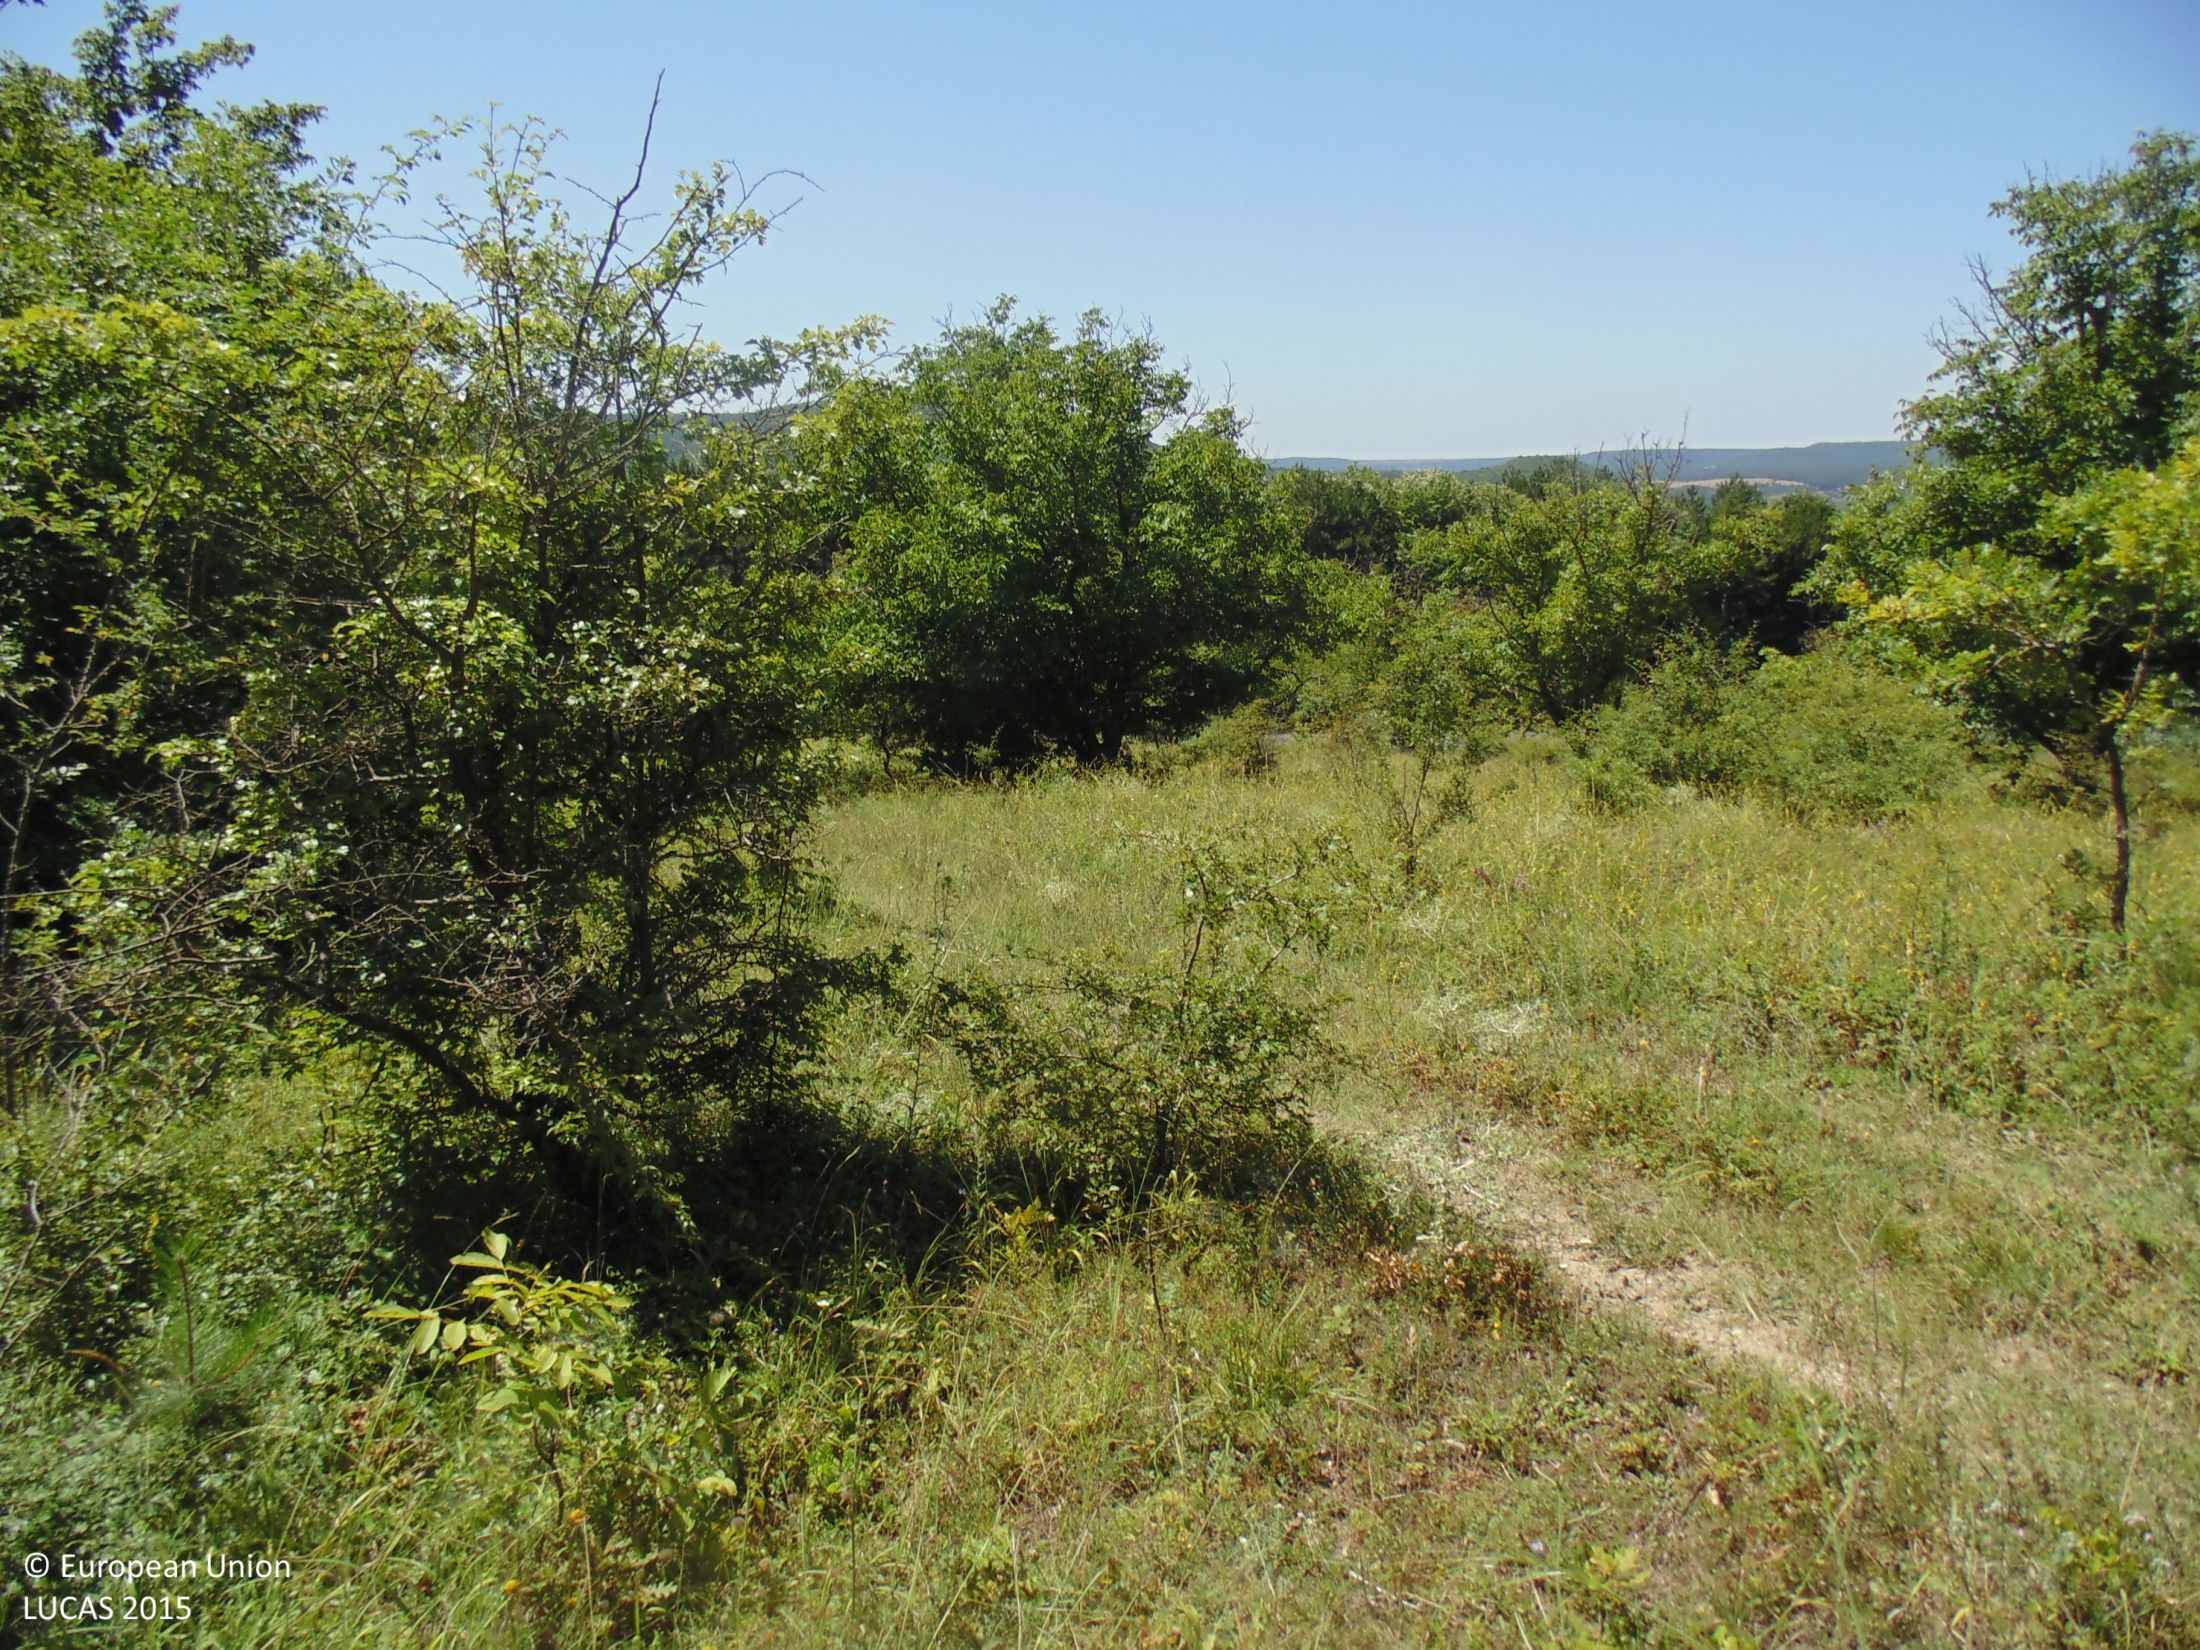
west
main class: Woodland
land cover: Broadleaved woodland
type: mesophytic deciduous forest
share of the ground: > 75 %
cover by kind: broadleaved forest trees 80 %, shrubs 15 %, consolidated bare surface 5 %
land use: Forestry
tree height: > 5 m
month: July
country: BG
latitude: 43.3953
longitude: 28.0603
